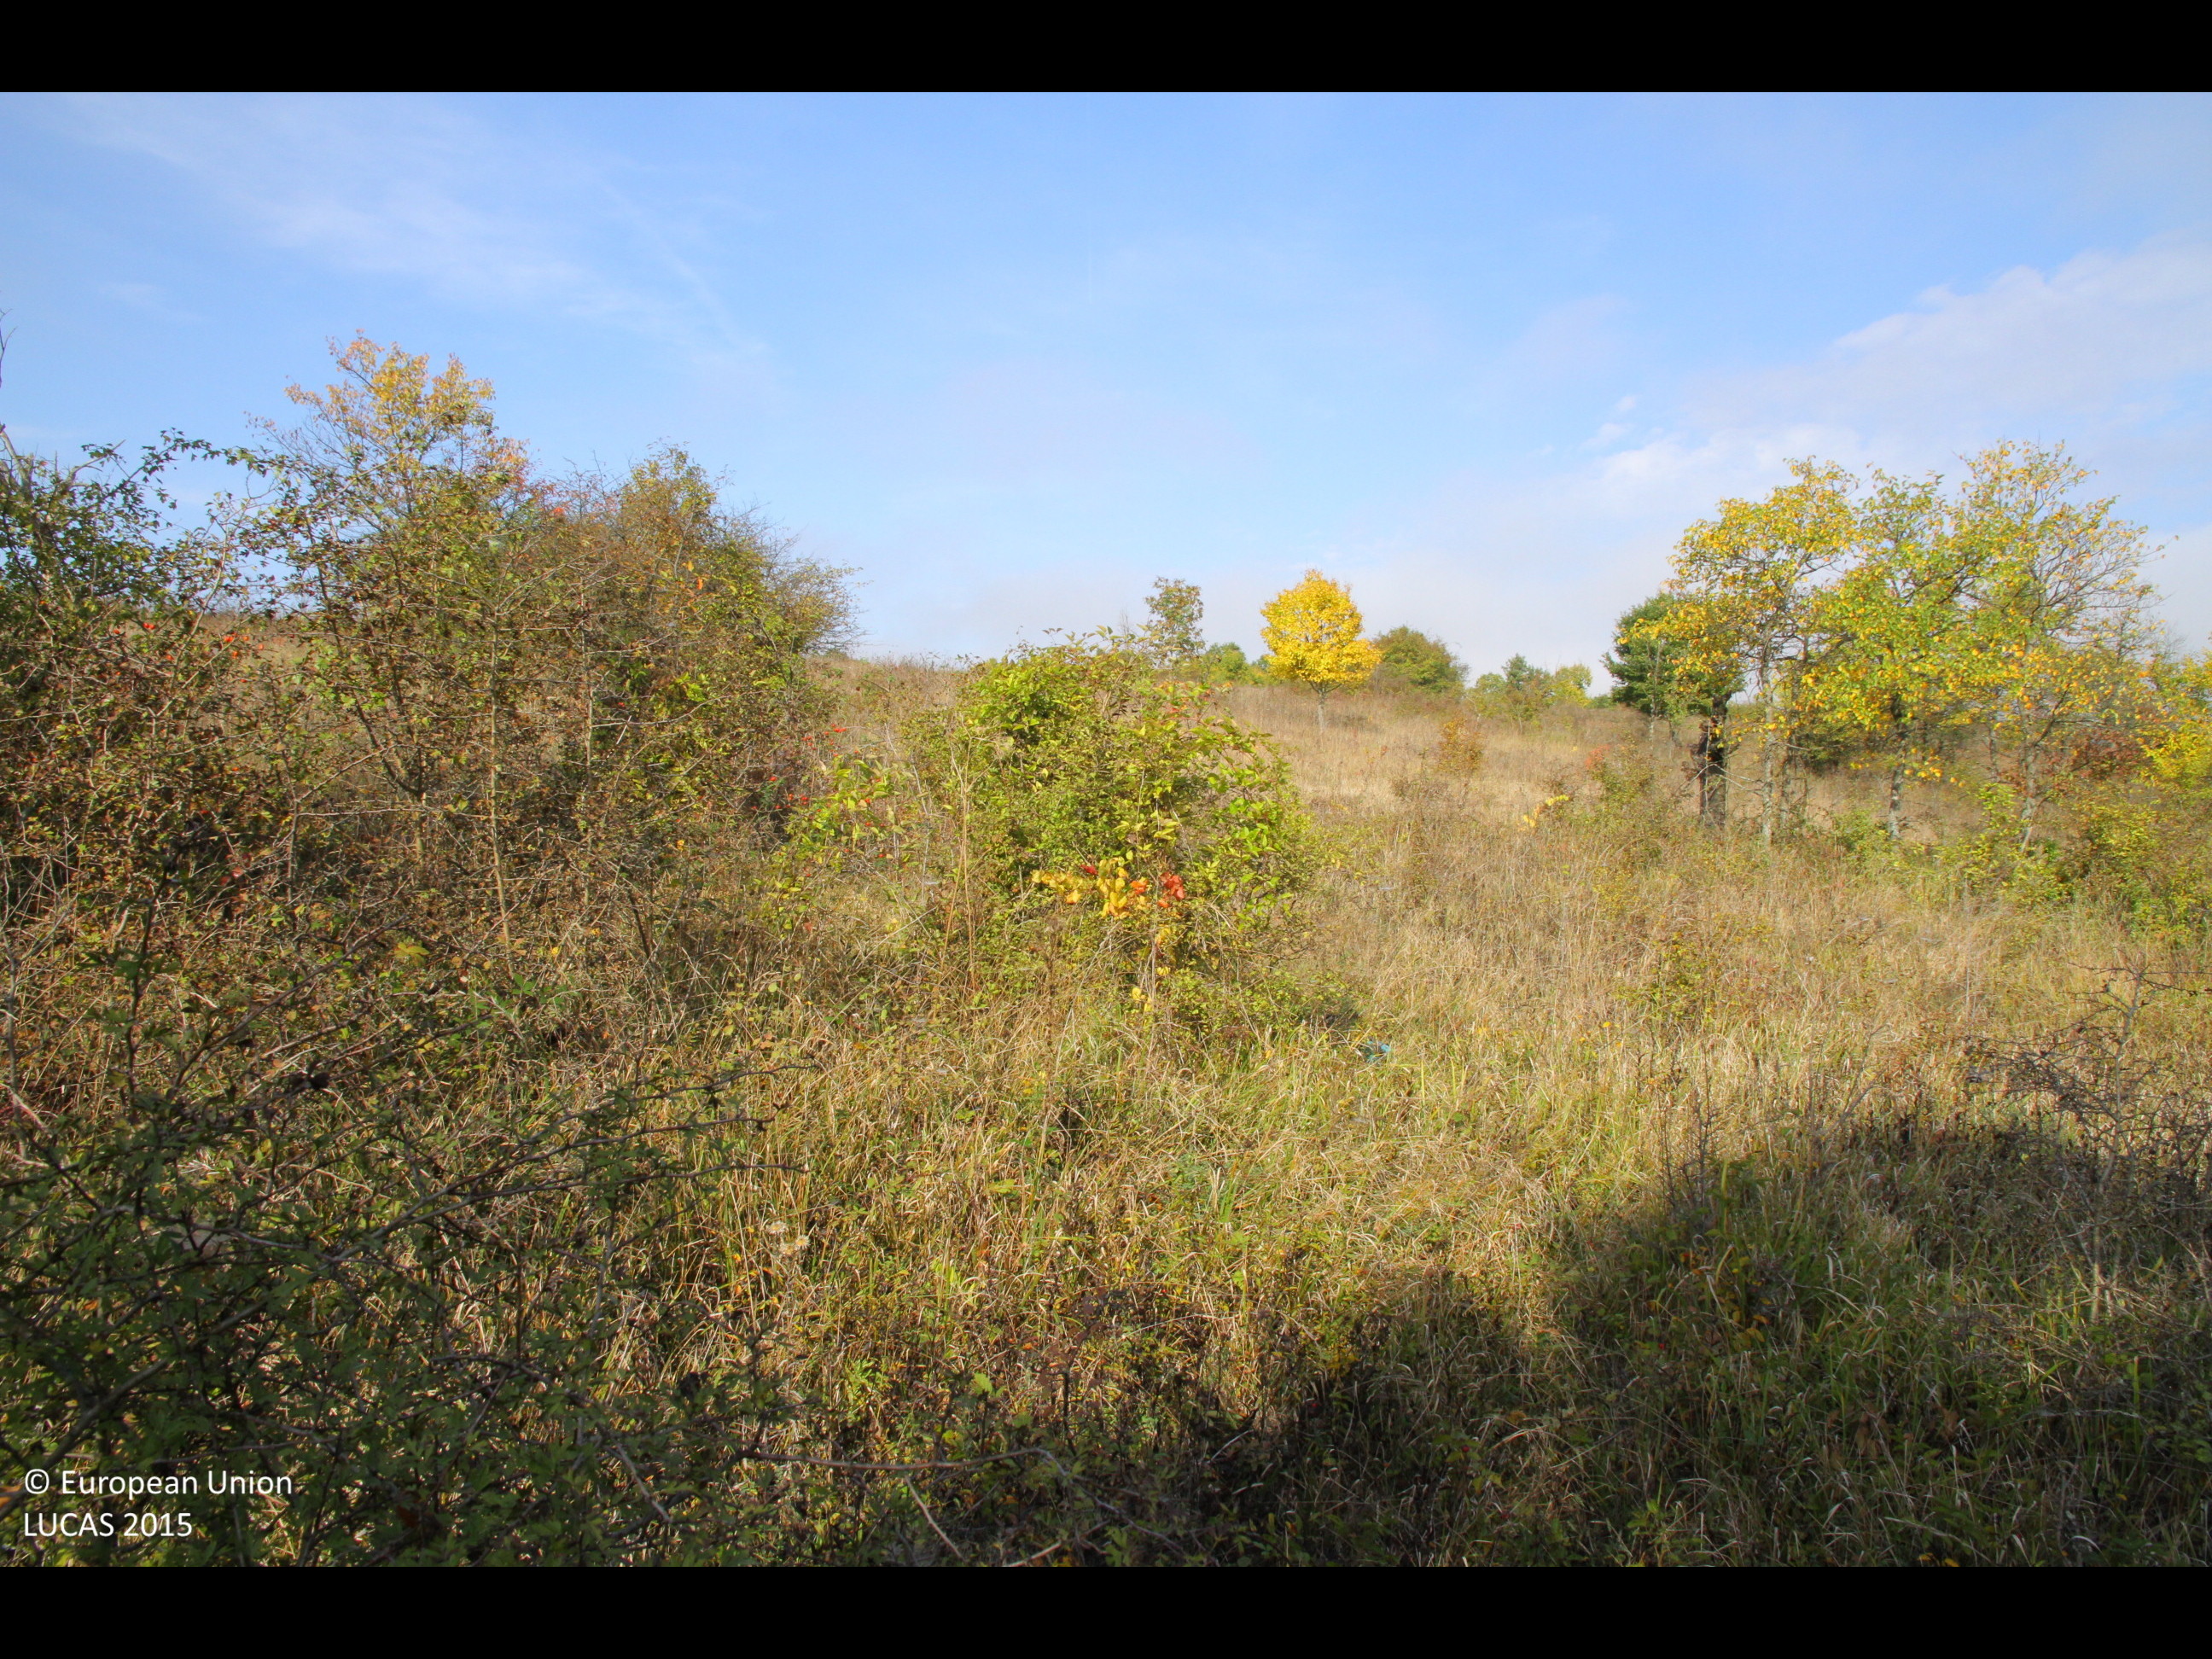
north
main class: Grassland
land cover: Grassland with sparse tree/shrub cover
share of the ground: > 75 %
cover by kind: herbaceous plants 85 %, shrubs 10 %, broadleaved forest trees 5 %
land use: Agriculture (excluding fallow land and kitchen gardens)
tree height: > 5 m
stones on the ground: < 10 %
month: October
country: BG
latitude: 43.0659
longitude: 27.0976
